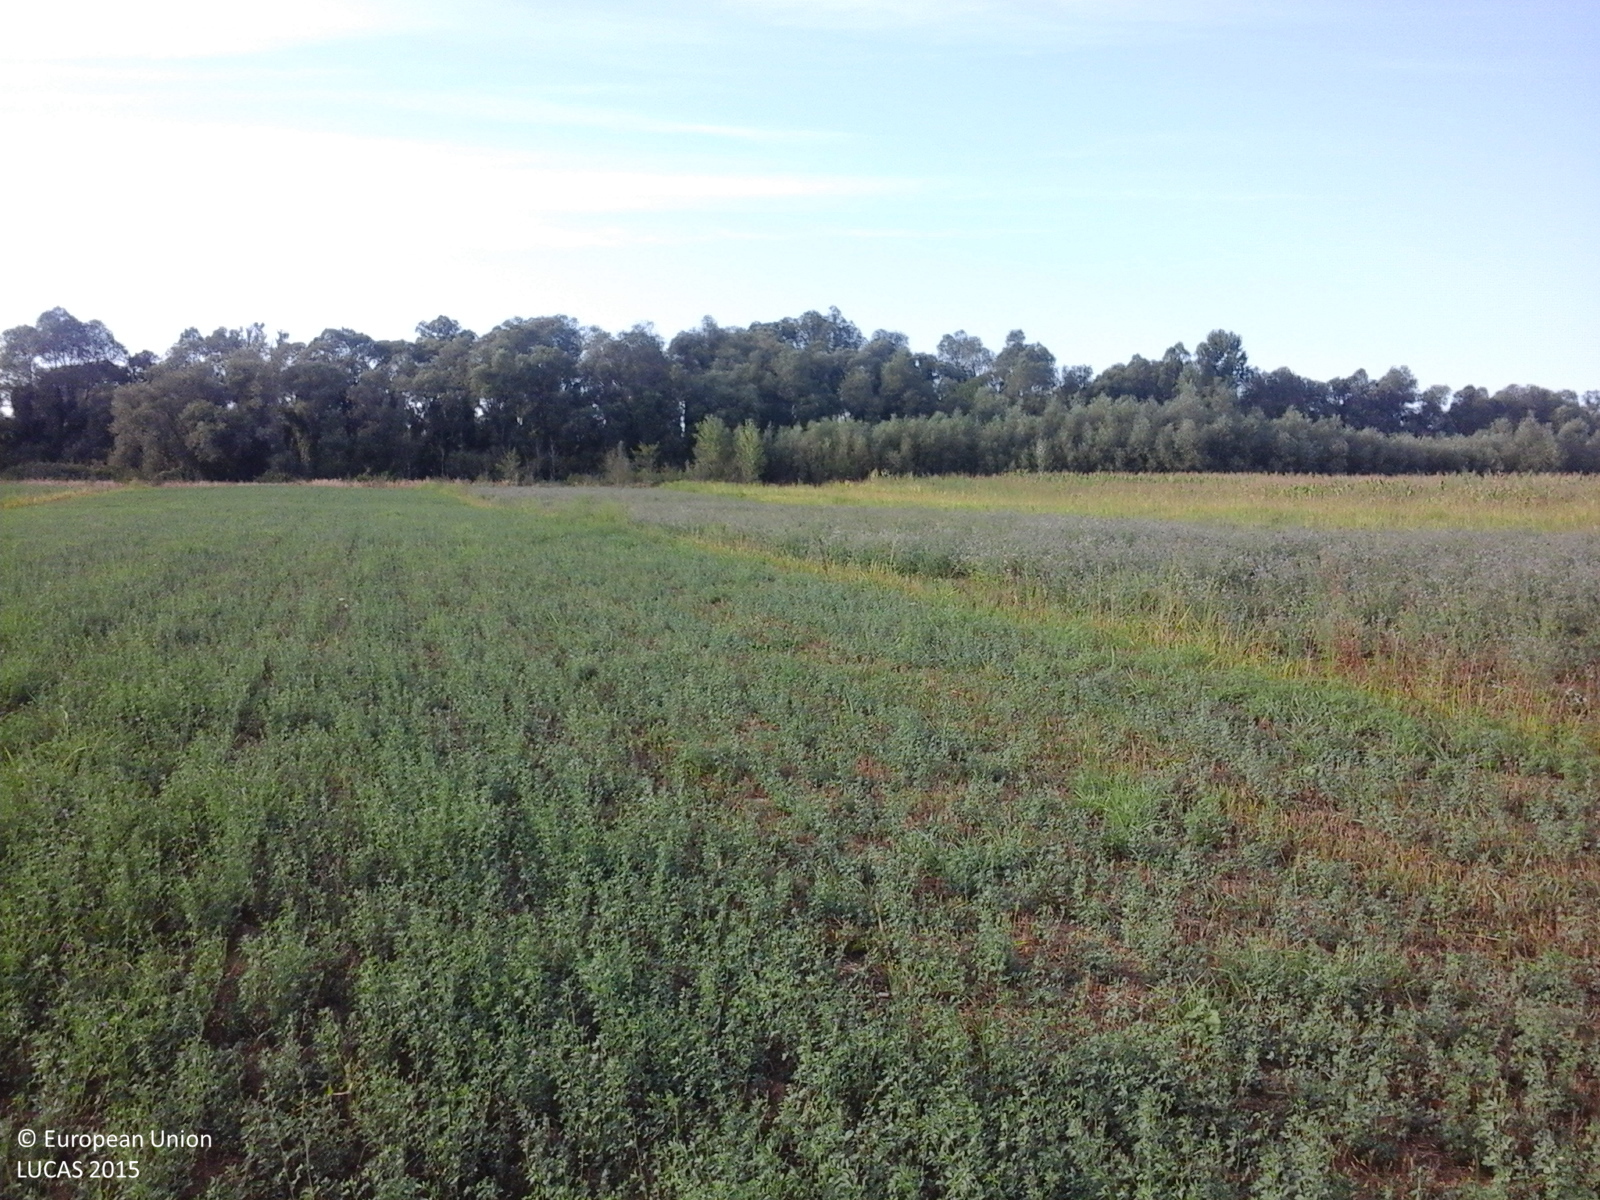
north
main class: Cropland
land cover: Lucerne
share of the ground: > 75 %
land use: Agriculture (excluding fallow land and kitchen gardens)
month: August
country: RO
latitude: 45.1311
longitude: 21.6404
